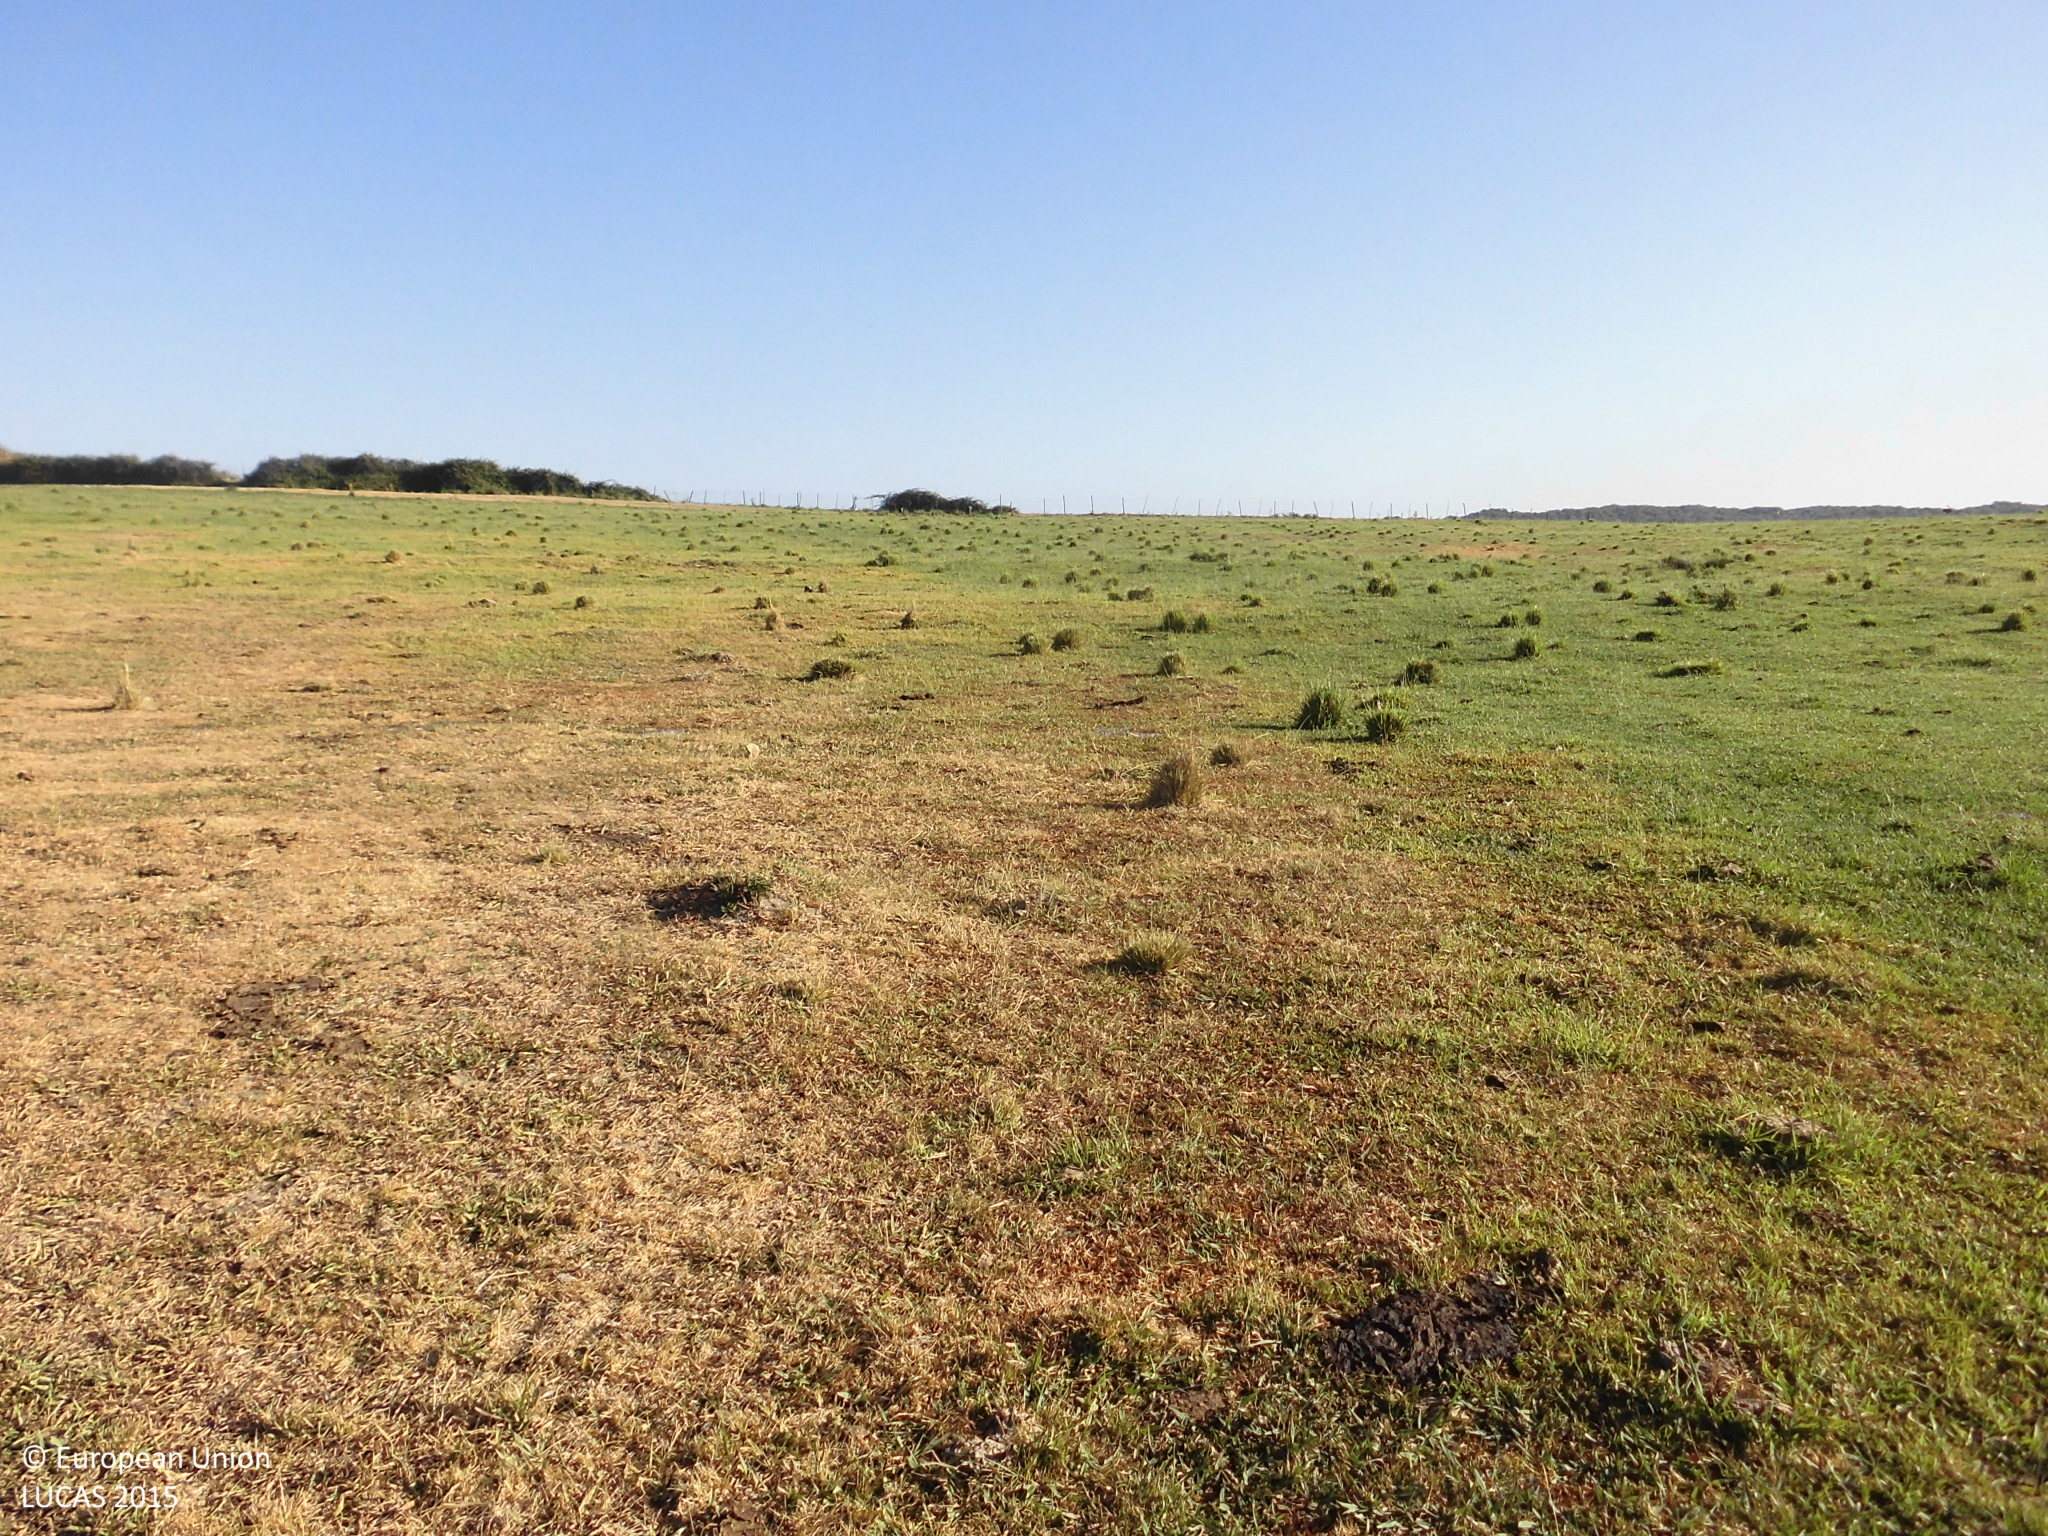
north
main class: Cropland
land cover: Temporary grasslands
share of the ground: > 75 %
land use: Agriculture (excluding fallow land and kitchen gardens)
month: July
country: ES
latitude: 40.0673
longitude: -6.2197
